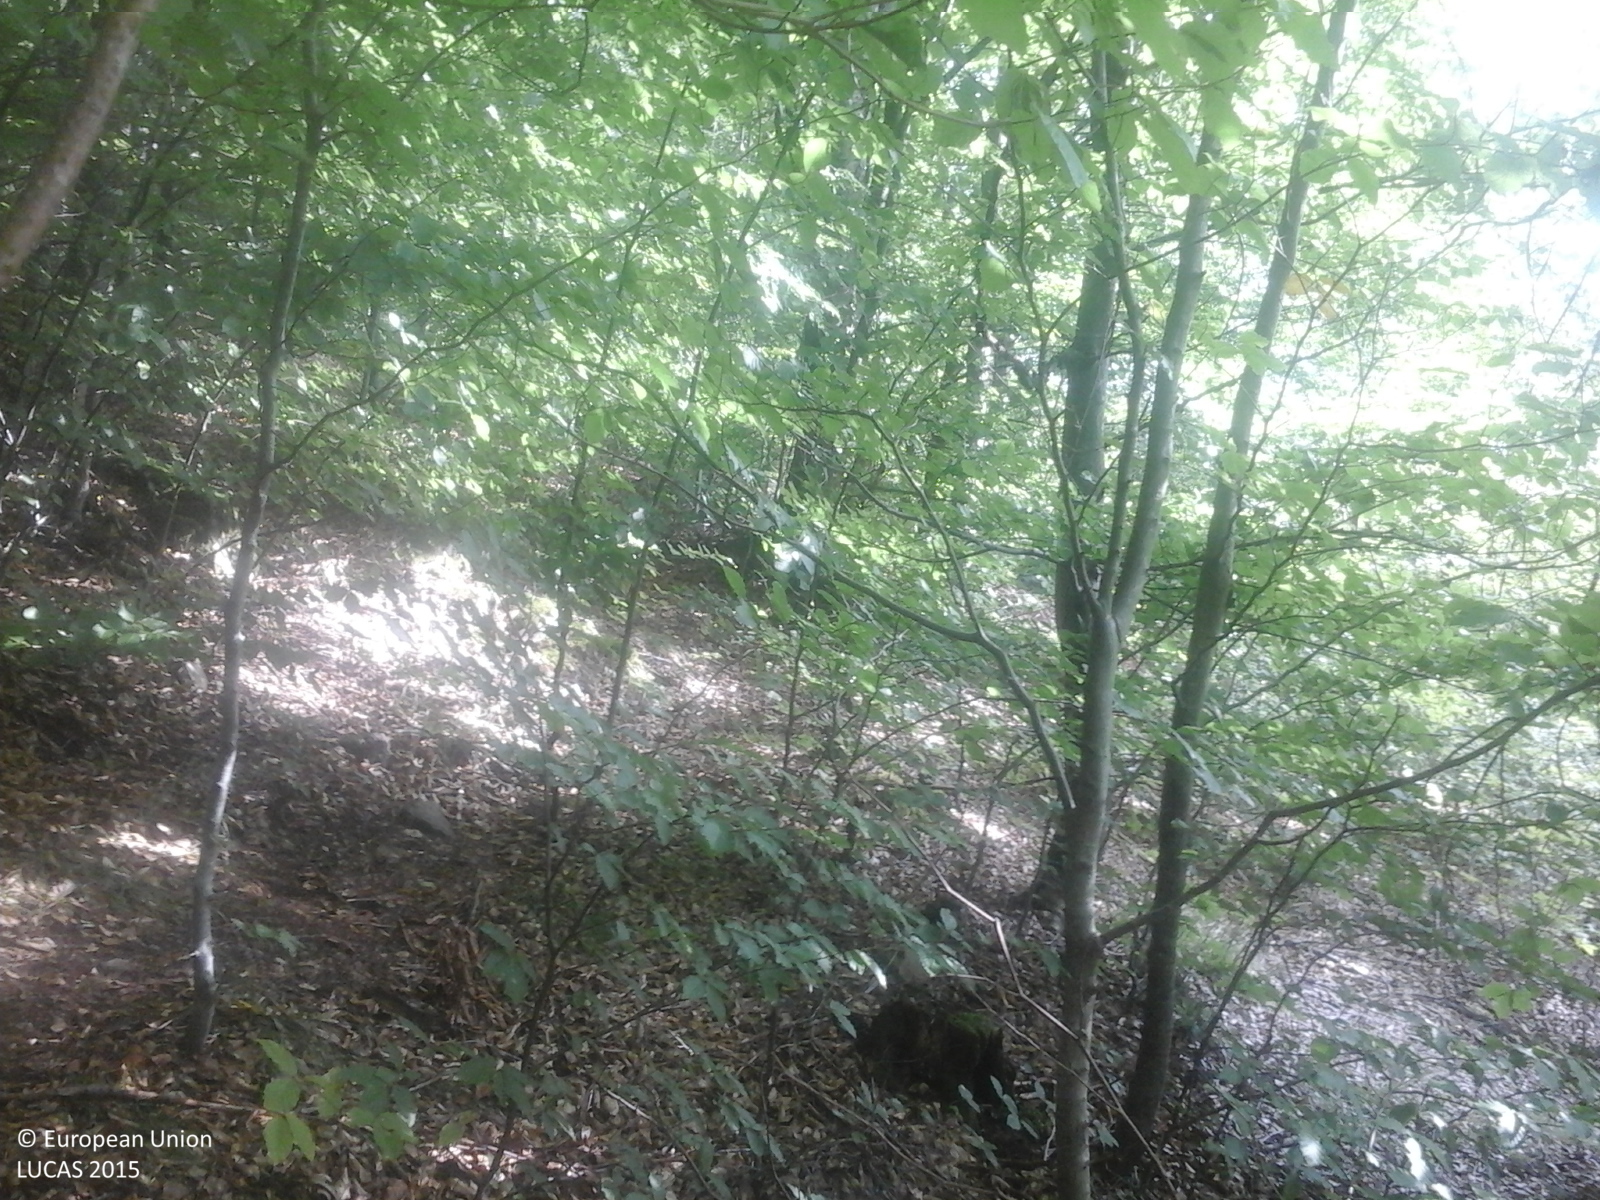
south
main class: Woodland
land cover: Broadleaved woodland
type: beech forest
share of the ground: > 75 %
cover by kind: broadleaved forest trees 100 %
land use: Forestry
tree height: > 5 m
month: September
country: RO
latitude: 46.9674
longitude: 22.7677
